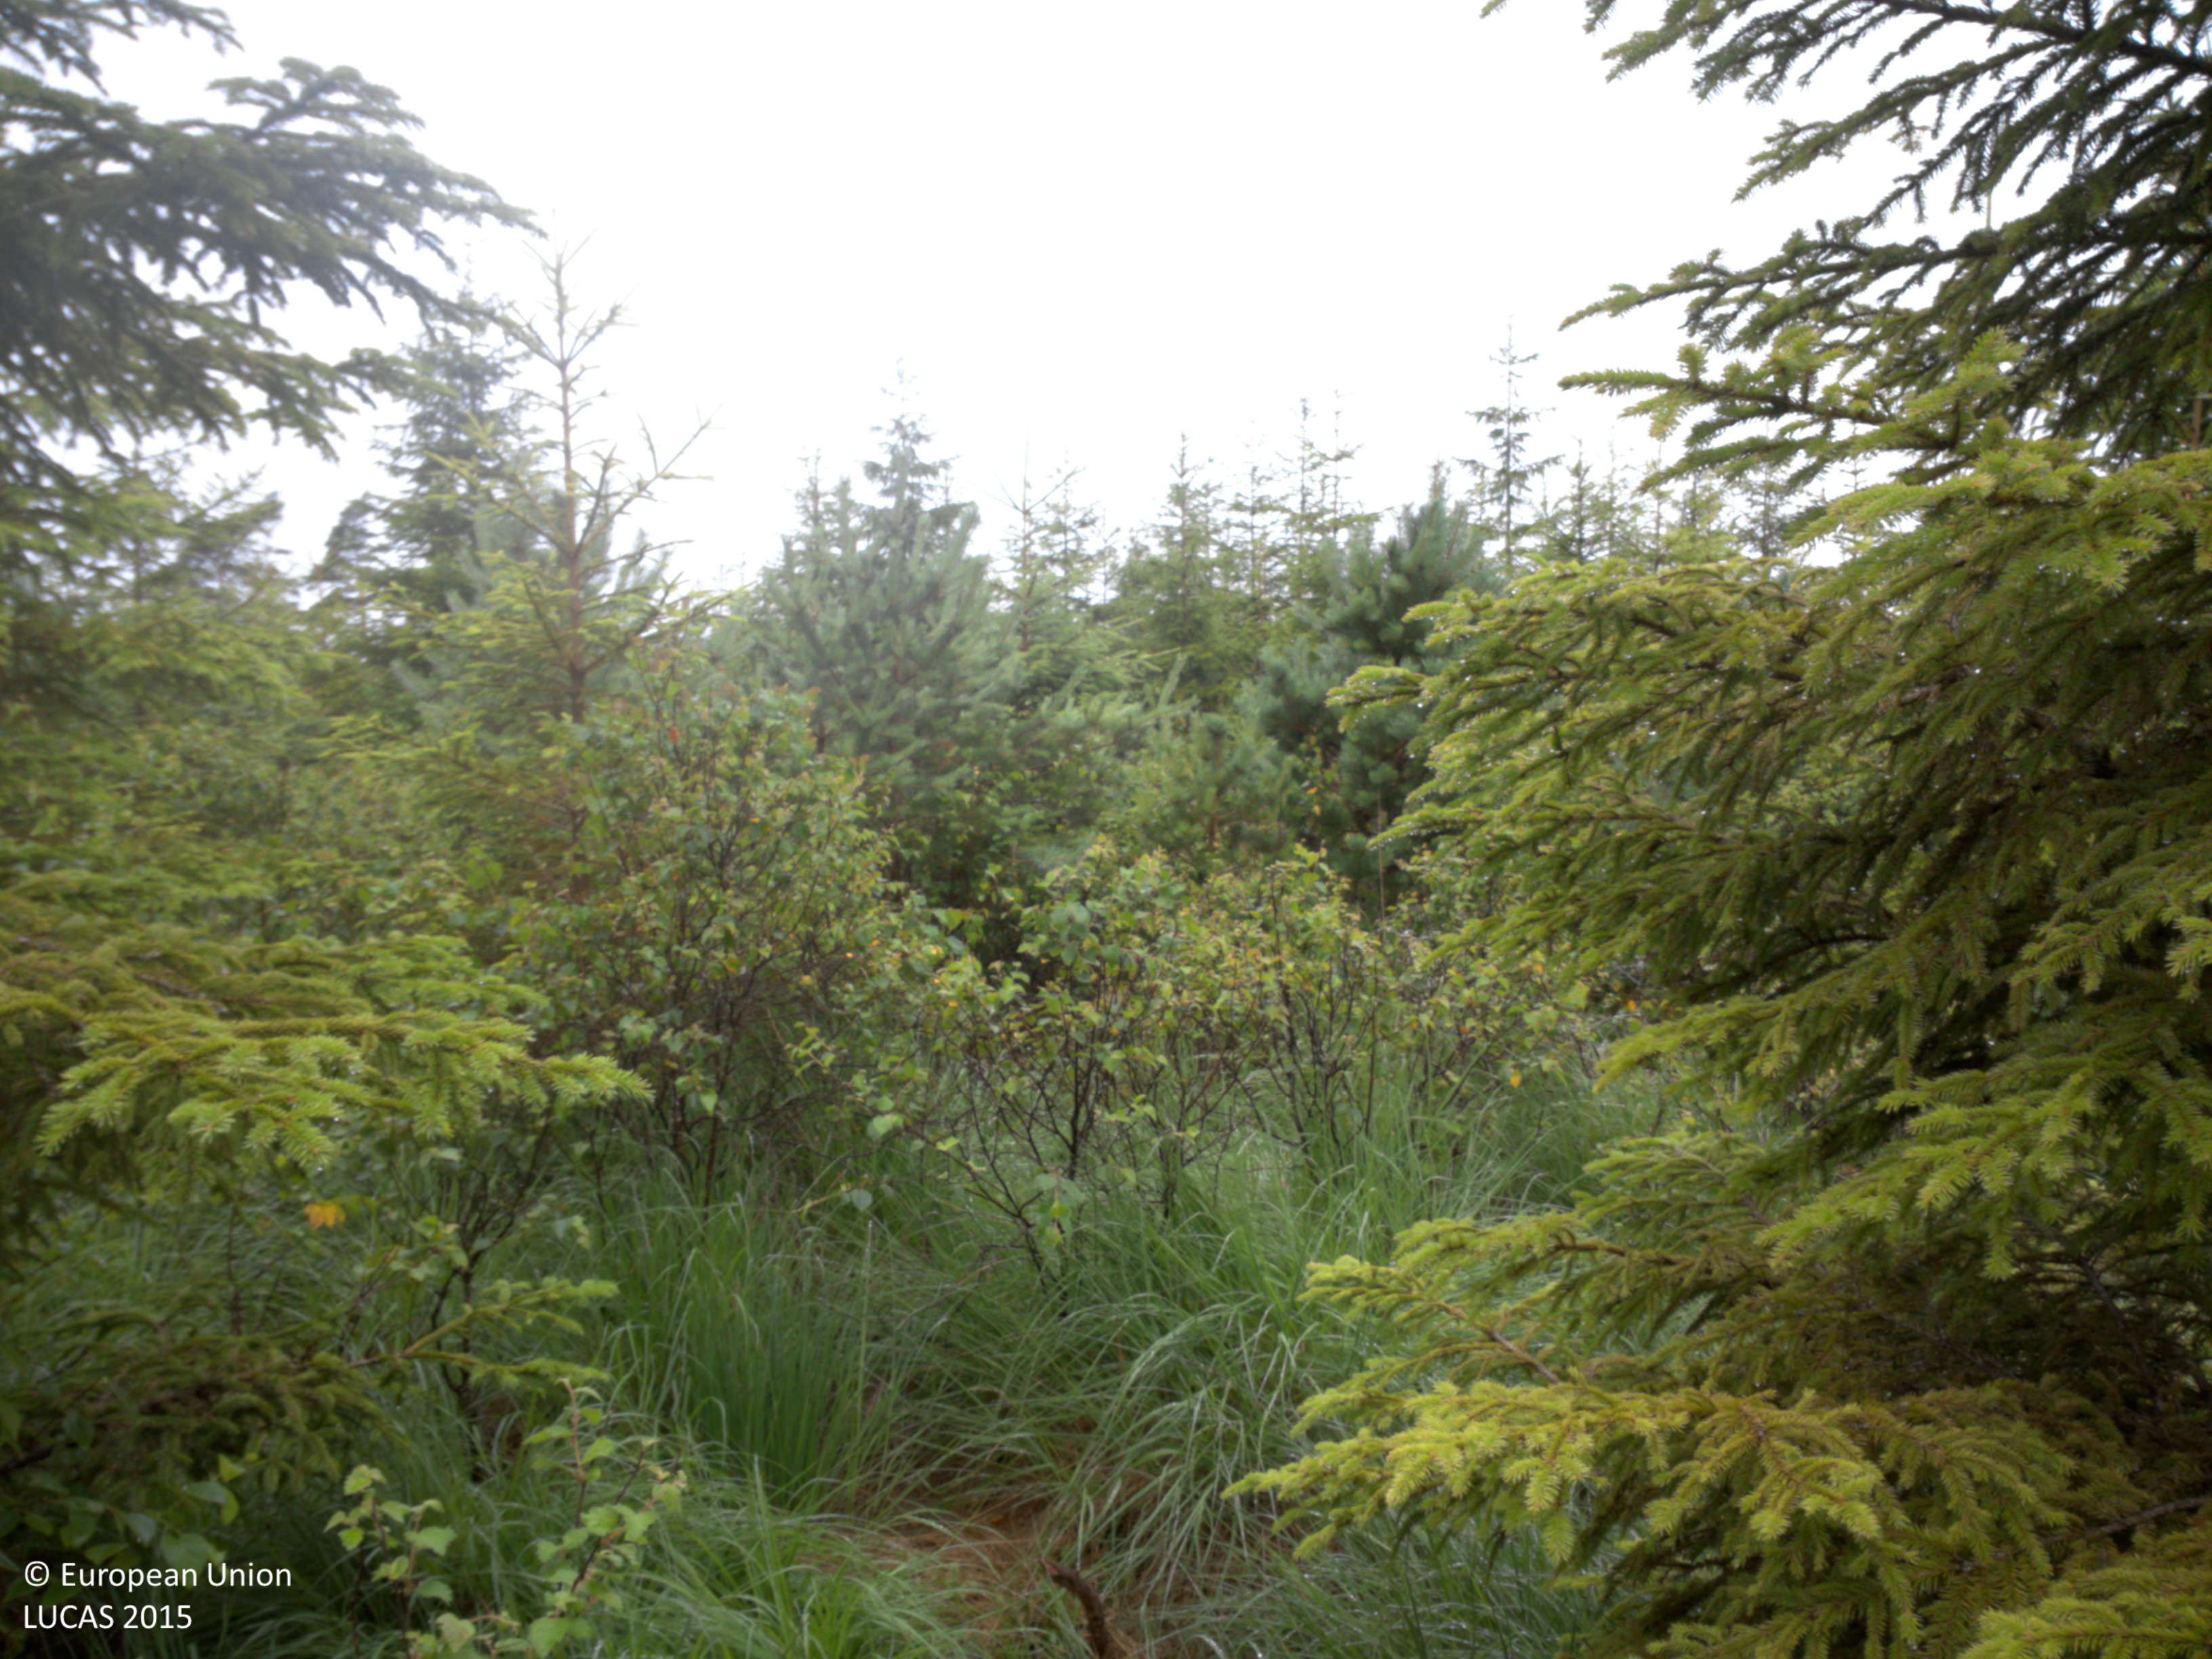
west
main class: Woodland
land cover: Spruce dominated mixed woodland
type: boreal forest
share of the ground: 50 - 75 %
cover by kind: coniferous forest trees 40 %, shrubs 40 %, broadleaved forest trees 20 %
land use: Forestry
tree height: > 5 m
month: July
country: SE
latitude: 58.6597
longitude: 11.5996
